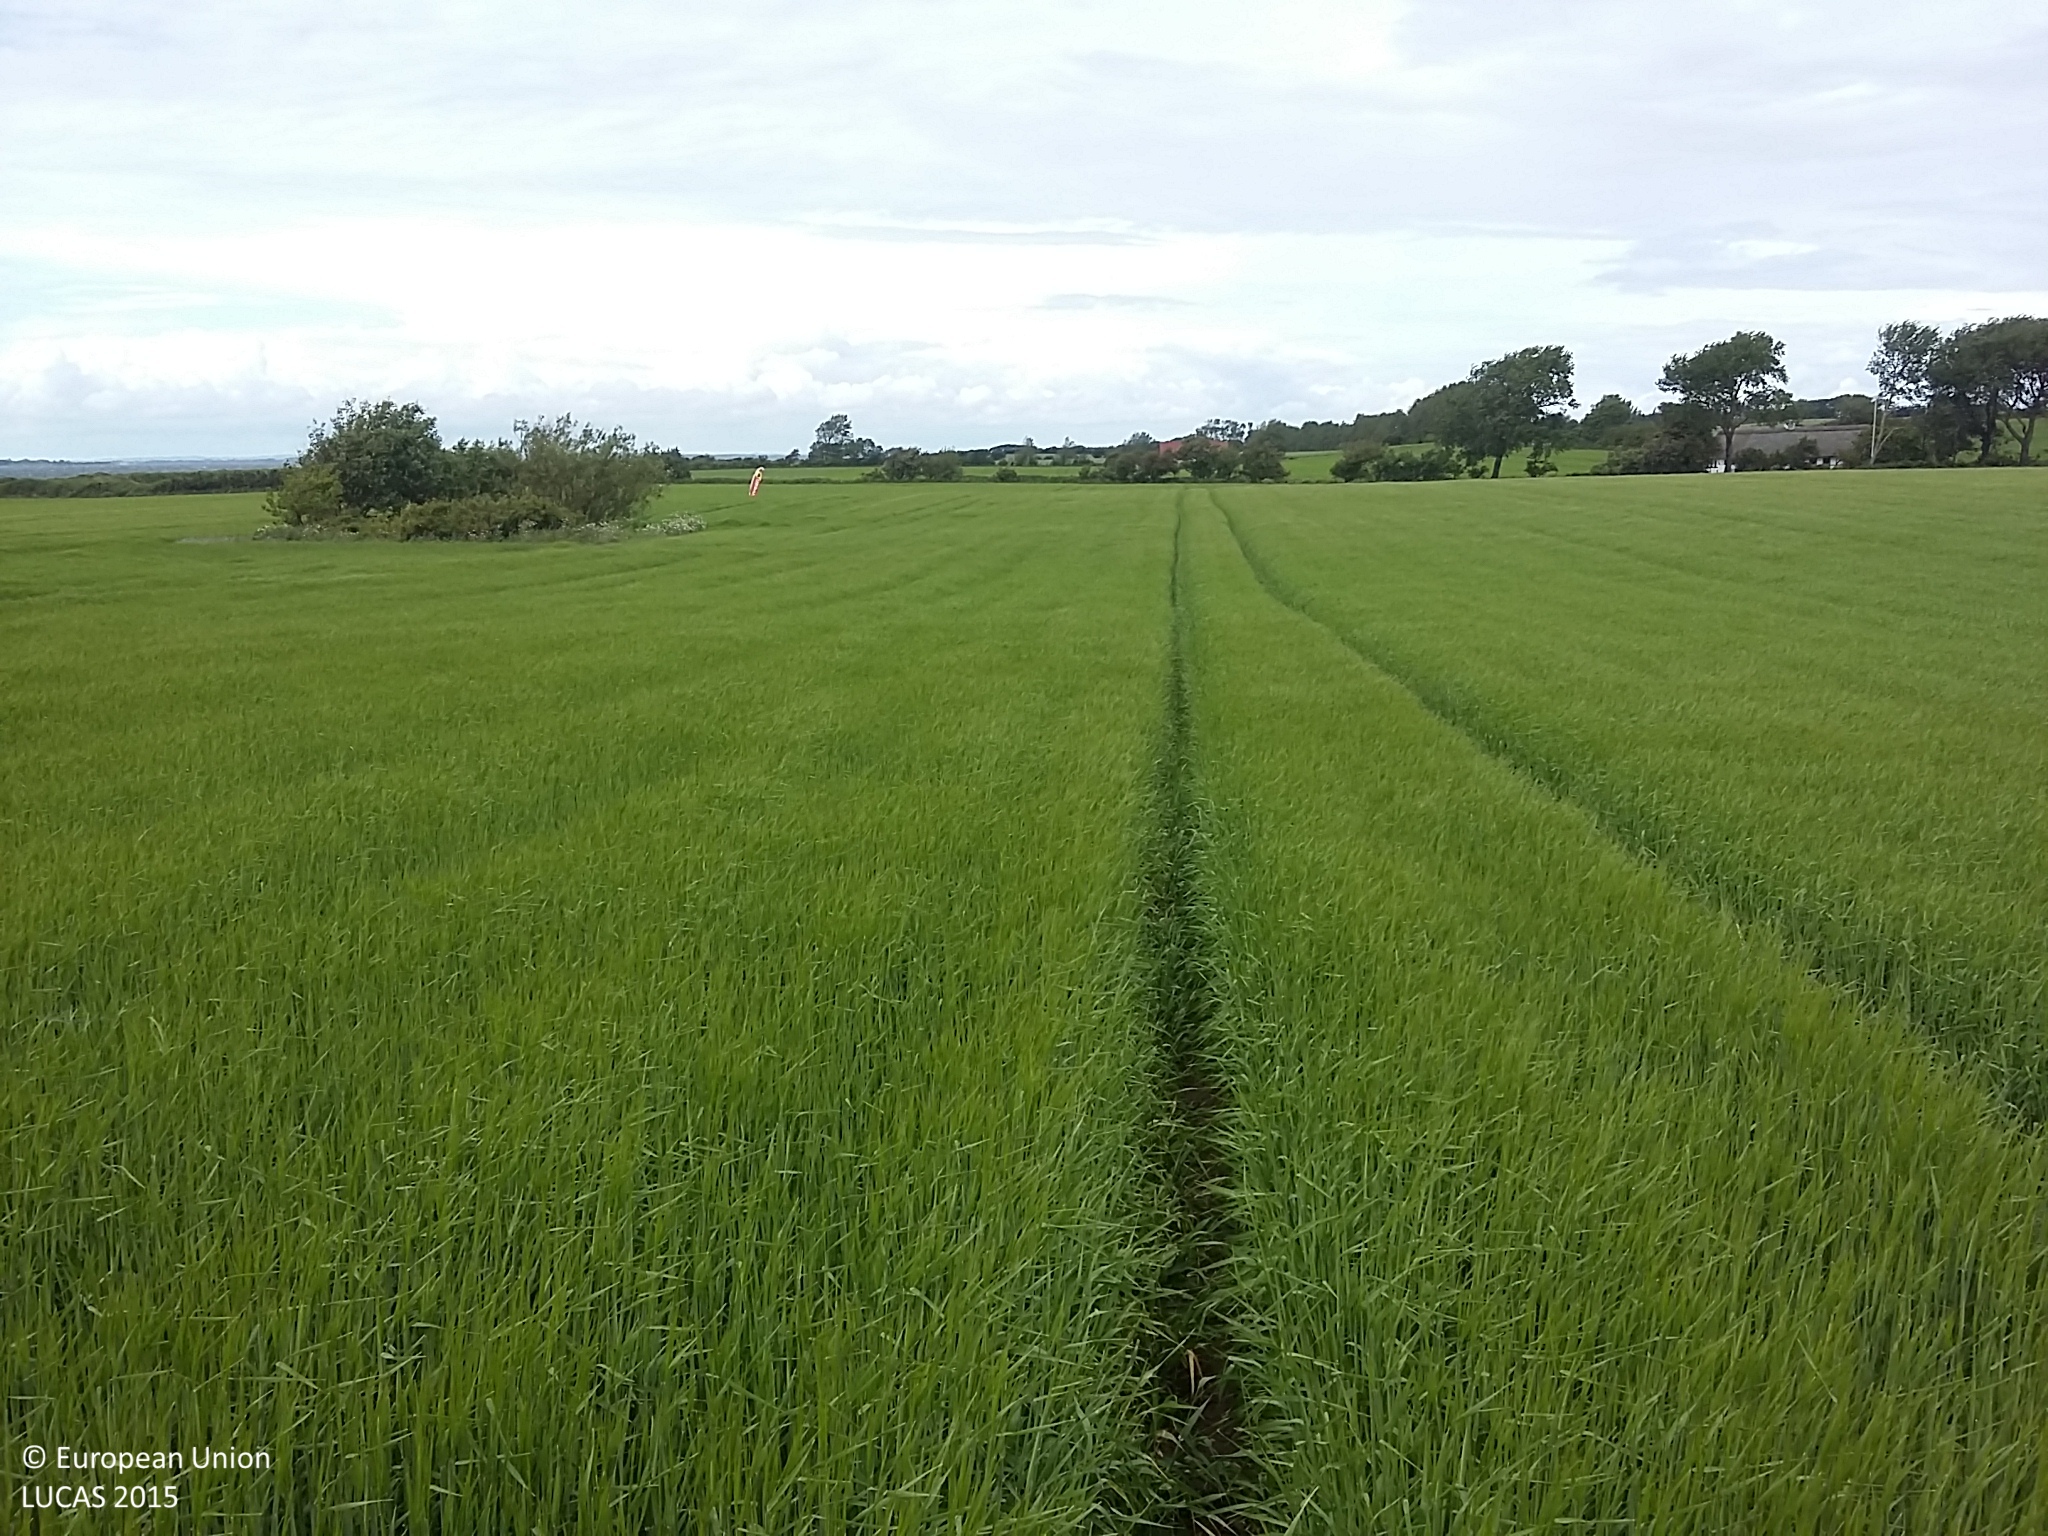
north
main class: Cropland
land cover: Barley
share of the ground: > 75 %
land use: Agriculture (excluding fallow land and kitchen gardens)
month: June
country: DK
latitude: 54.8559
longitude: 10.6693
